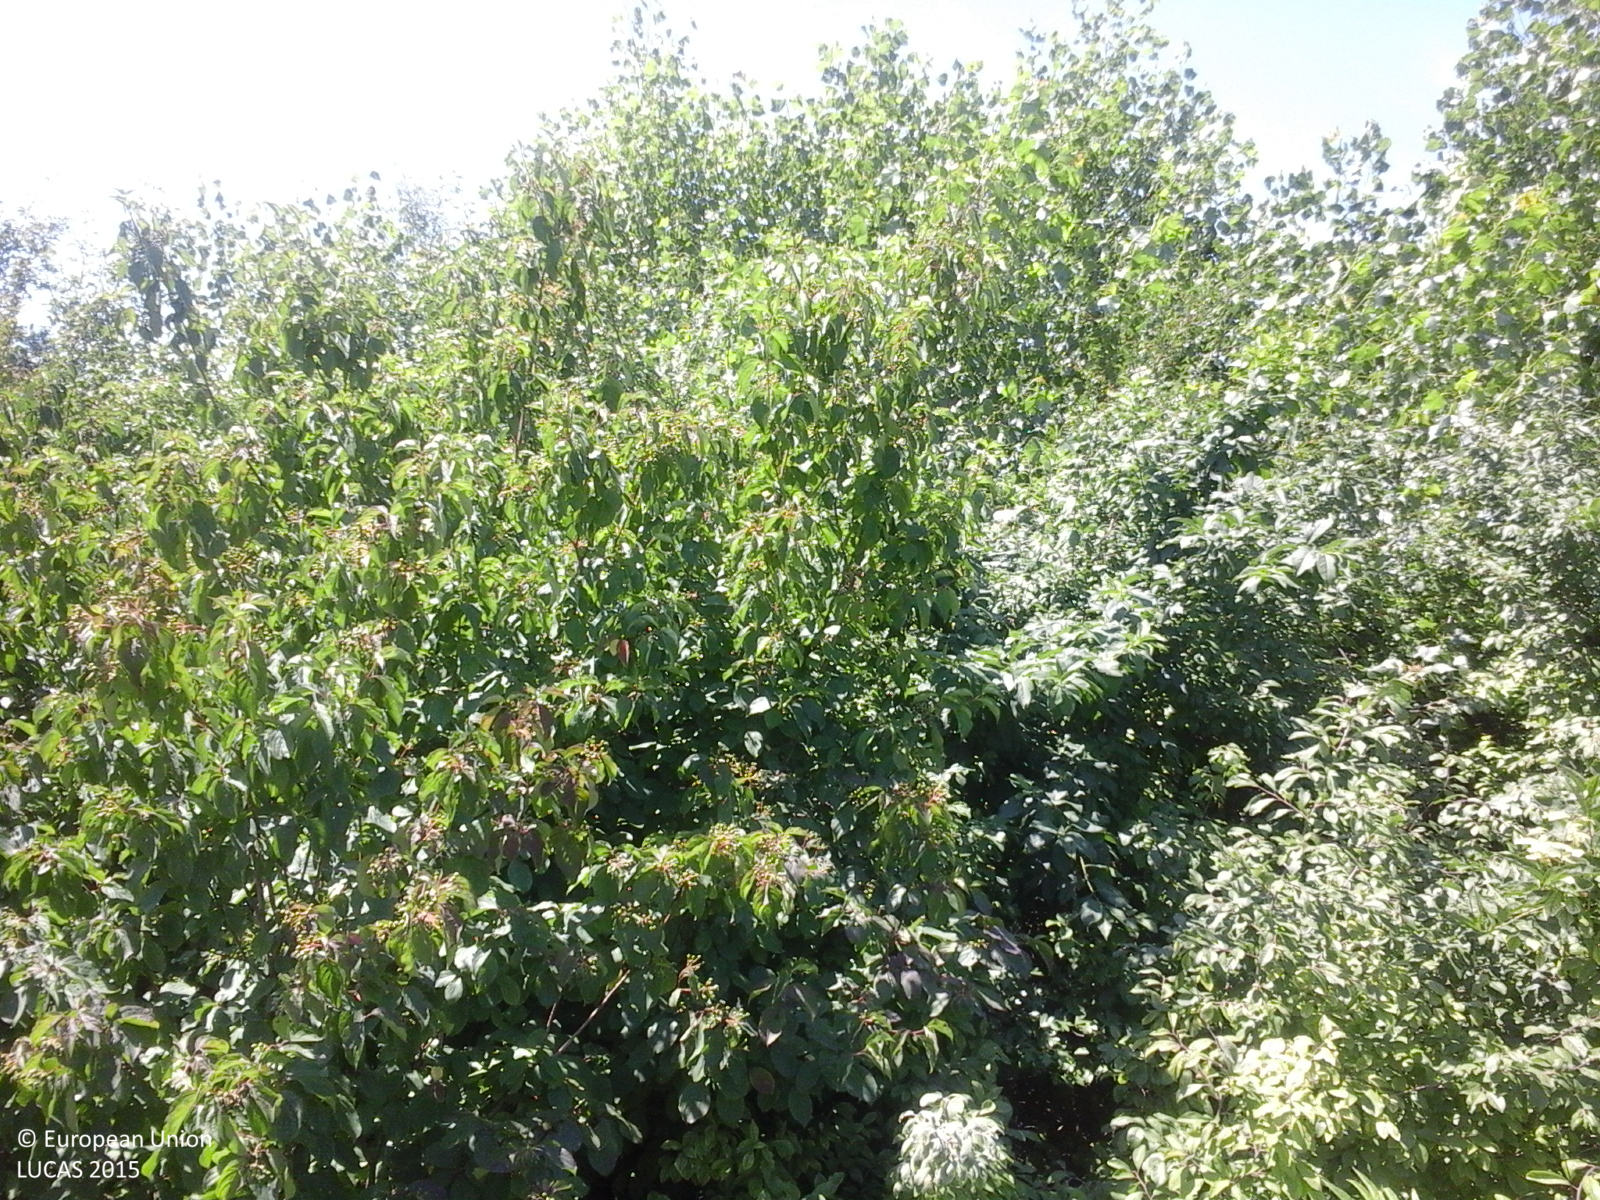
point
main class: Shrubland
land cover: Shrubland with sparse tree cover
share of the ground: > 75 %
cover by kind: shrubs 95 %, broadleaved forest trees 5 %
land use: Abandoned areas
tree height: > 5 m
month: June
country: RO
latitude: 47.7975
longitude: 27.0760
